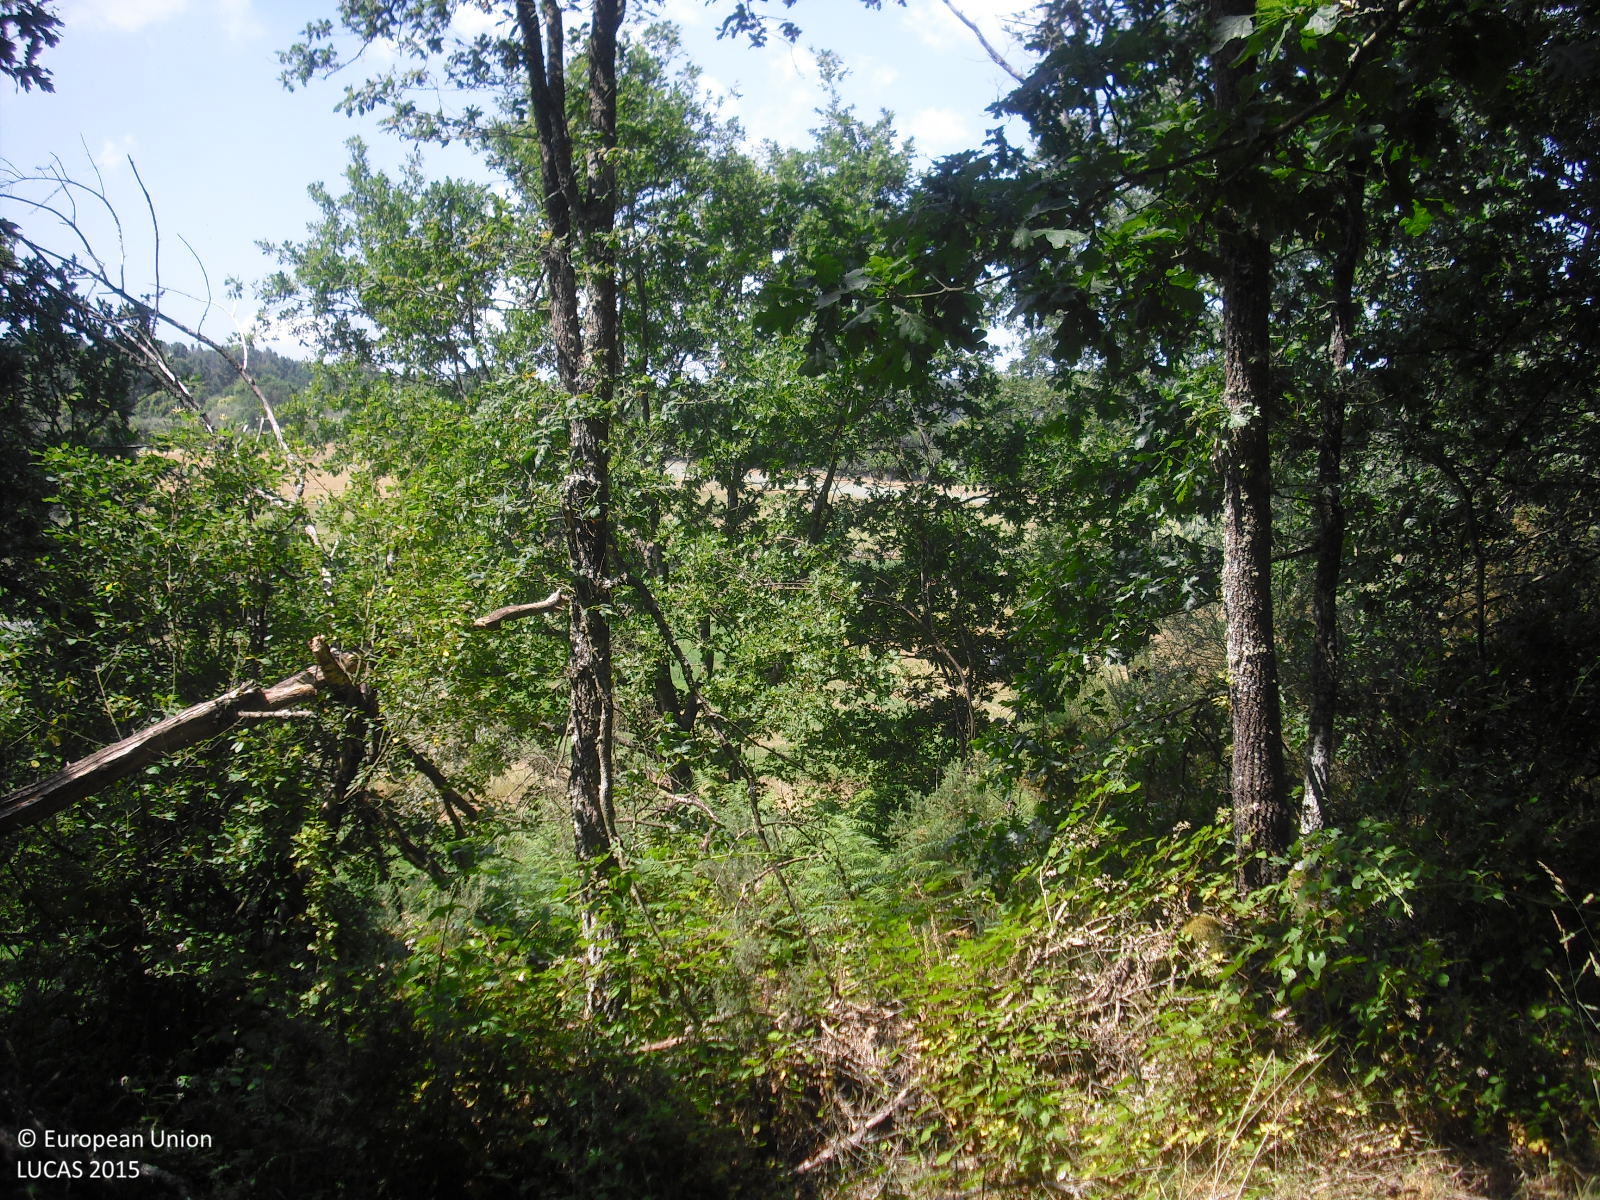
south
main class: Woodland
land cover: Broadleaved woodland
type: acidophilous oak and oak-birch forest
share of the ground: > 75 %
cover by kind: broadleaved forest trees 100 %
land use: Semi-natural and natural areas not in use
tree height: > 5 m
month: June
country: ES
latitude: 42.6441
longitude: -7.8261
